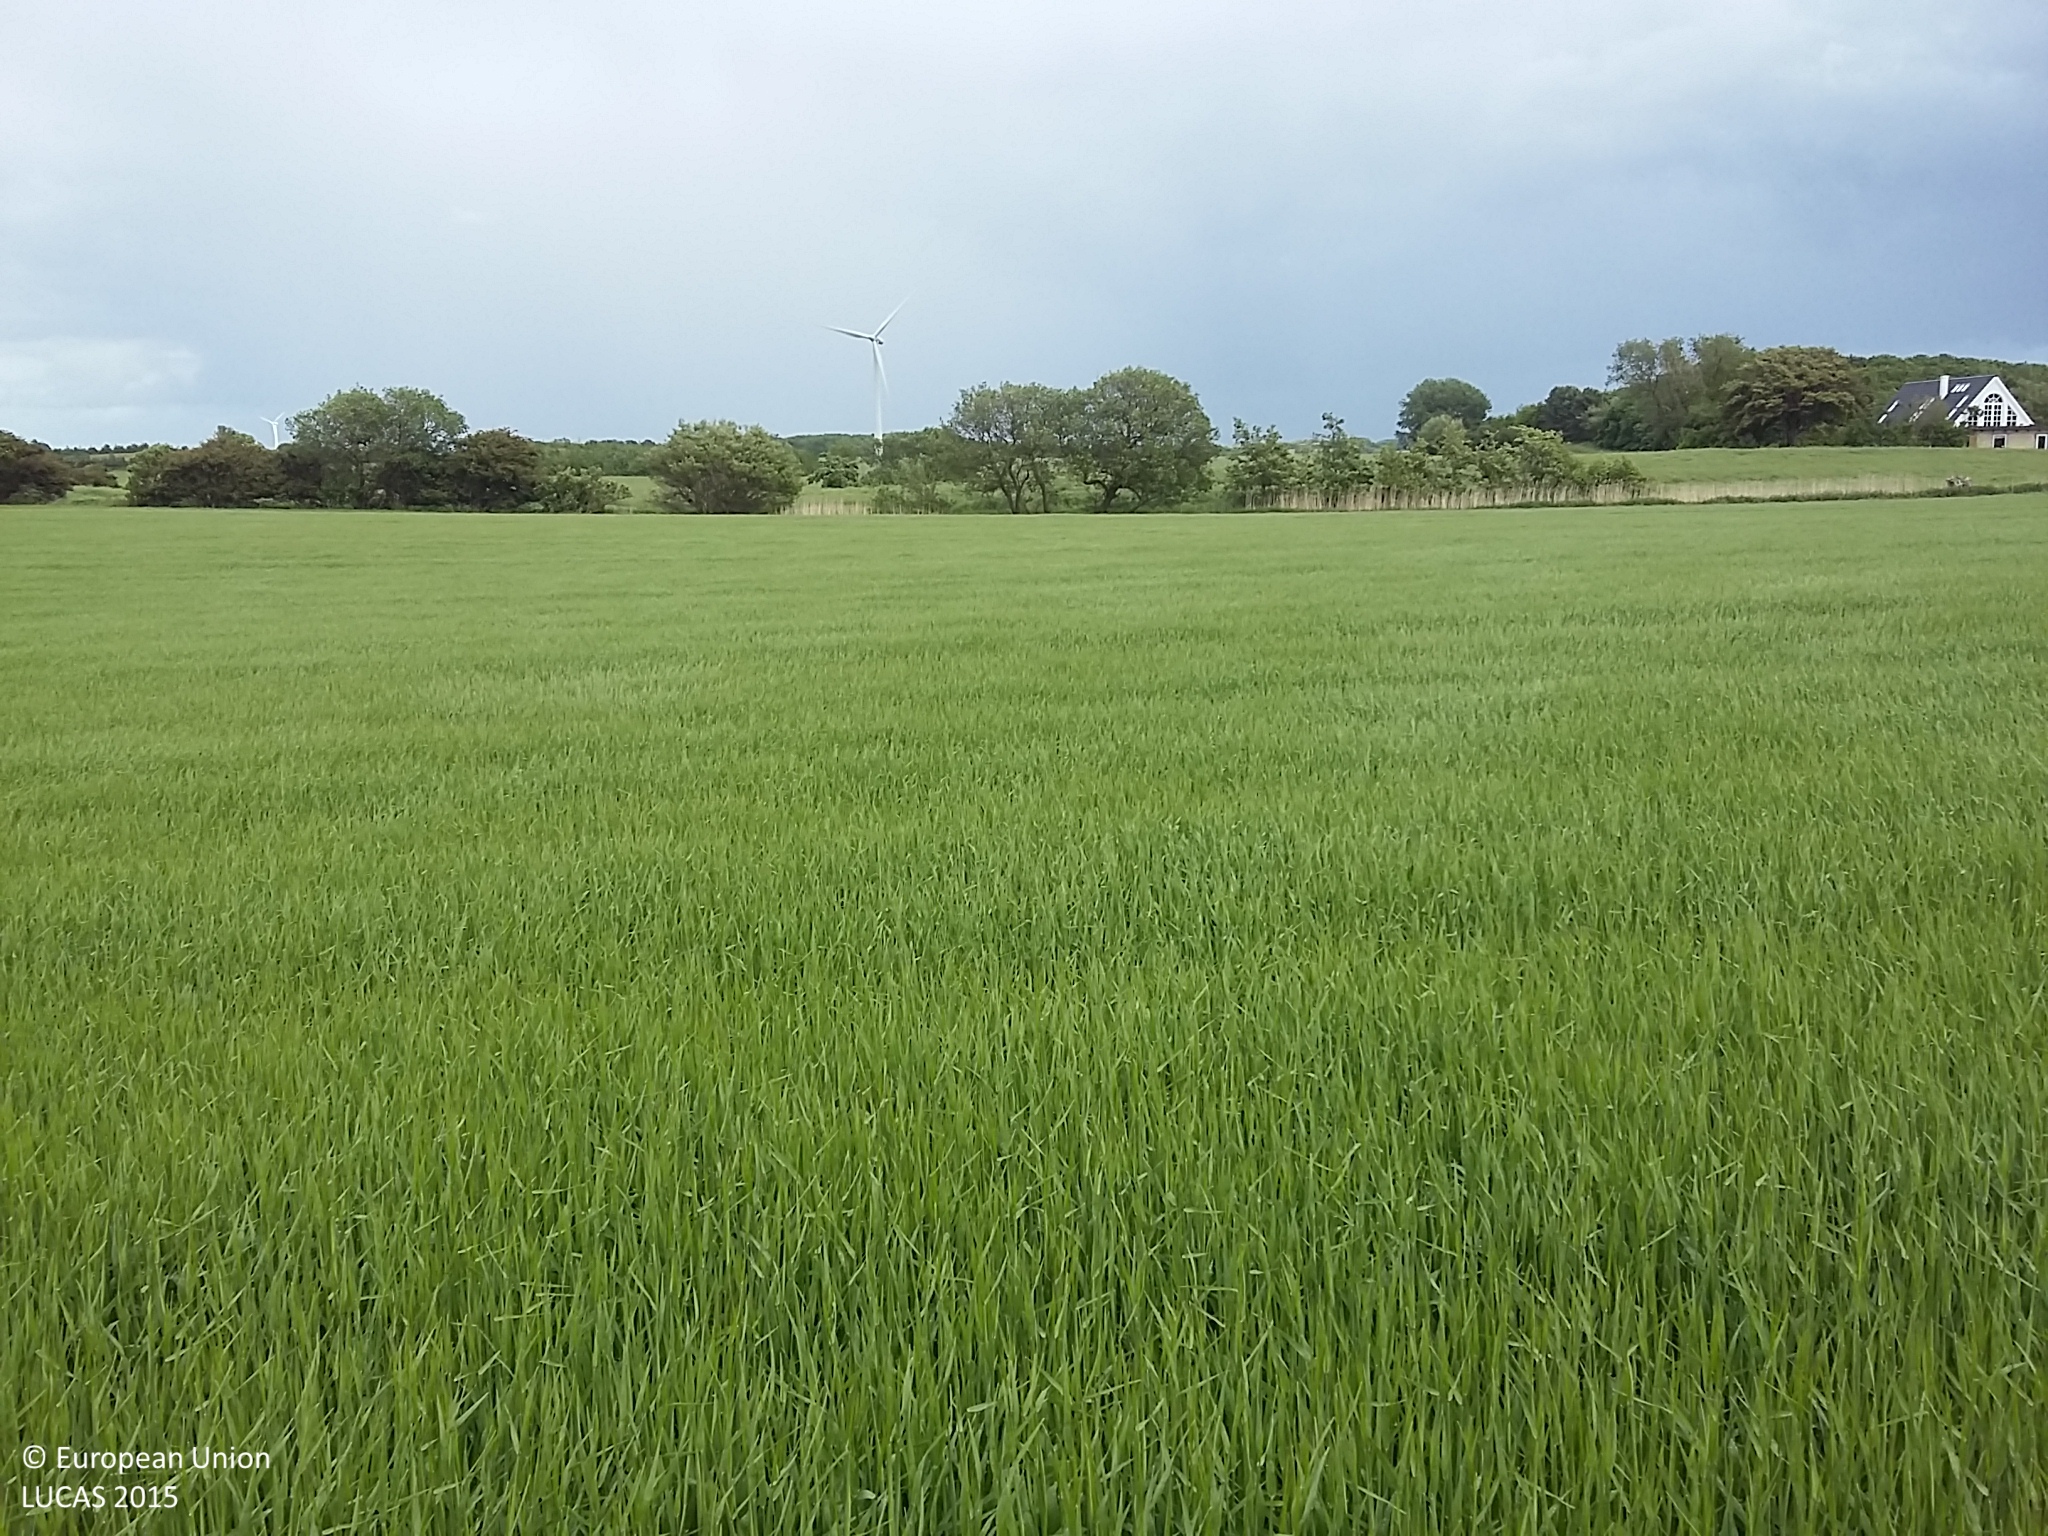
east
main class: Cropland
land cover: Barley
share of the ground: > 75 %
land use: Agriculture (excluding fallow land and kitchen gardens)
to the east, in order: Barley; Broadleaved woodland; Inland fresh water bodies; Rape and turnip rape; Single bushes/trees; Rape and turnip rape
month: June
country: DK
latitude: 54.8559
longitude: 10.6693
